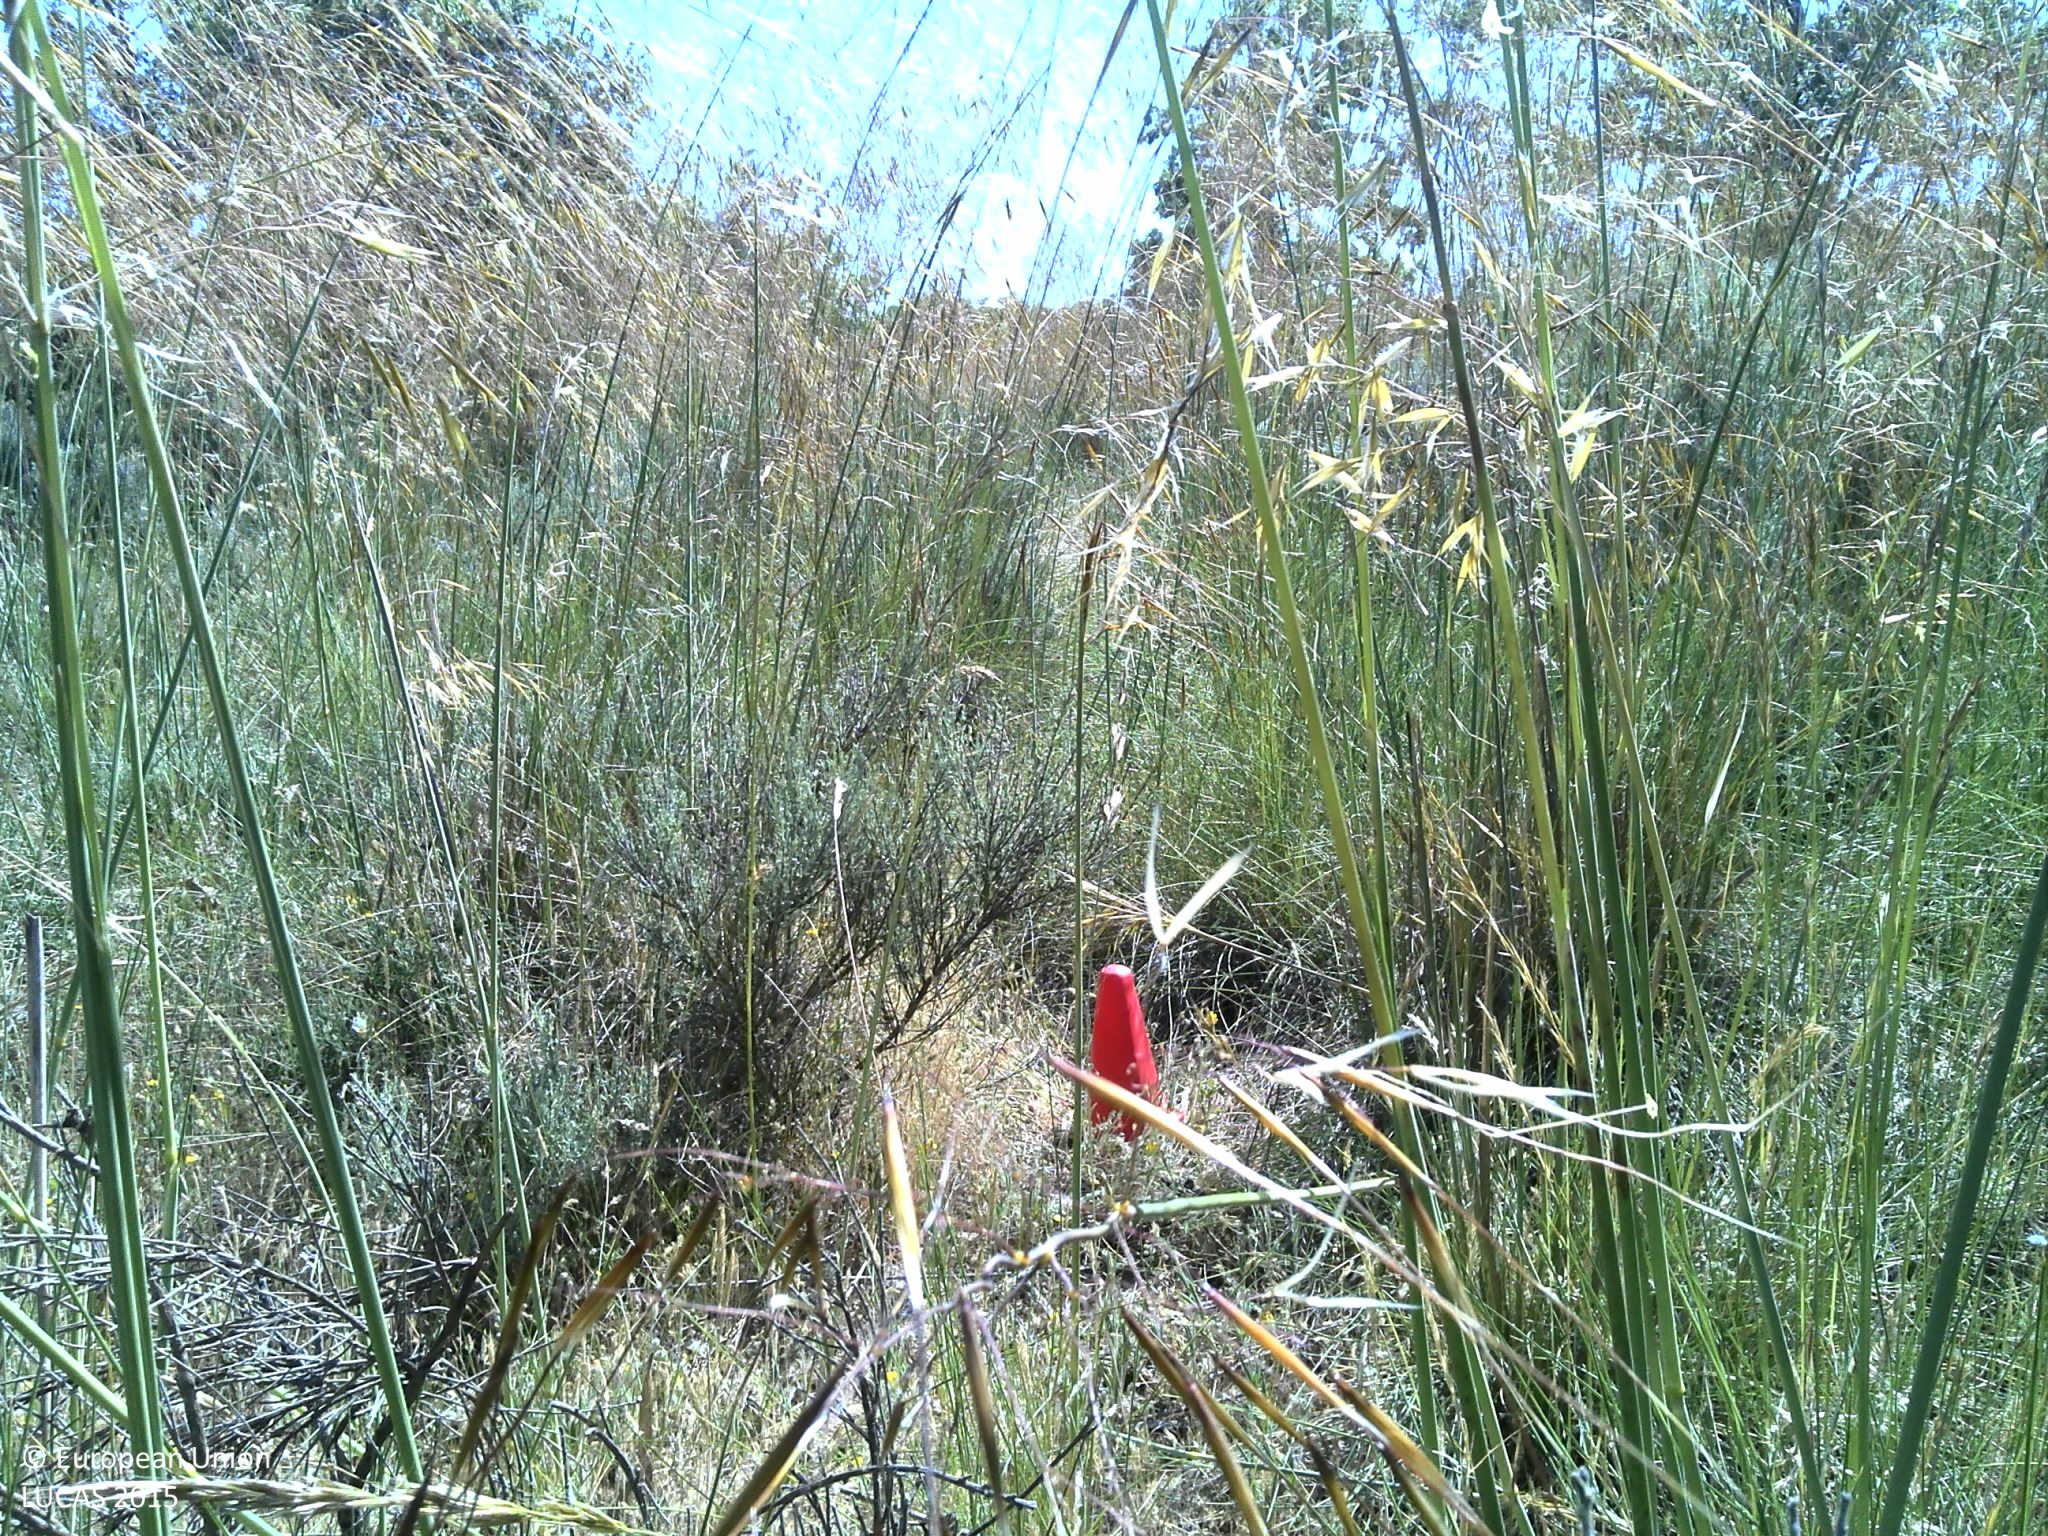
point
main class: Shrubland
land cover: Shrubland with sparse tree cover
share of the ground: 25 - 50 %
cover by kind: shrubs 50 %, herbaceous plants 30 %, lichens and mosses 15 %, broadleaved forest trees 5 %
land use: Abandoned areas
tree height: > 5 m
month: May
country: PT
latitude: 41.4589
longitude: -6.3690
